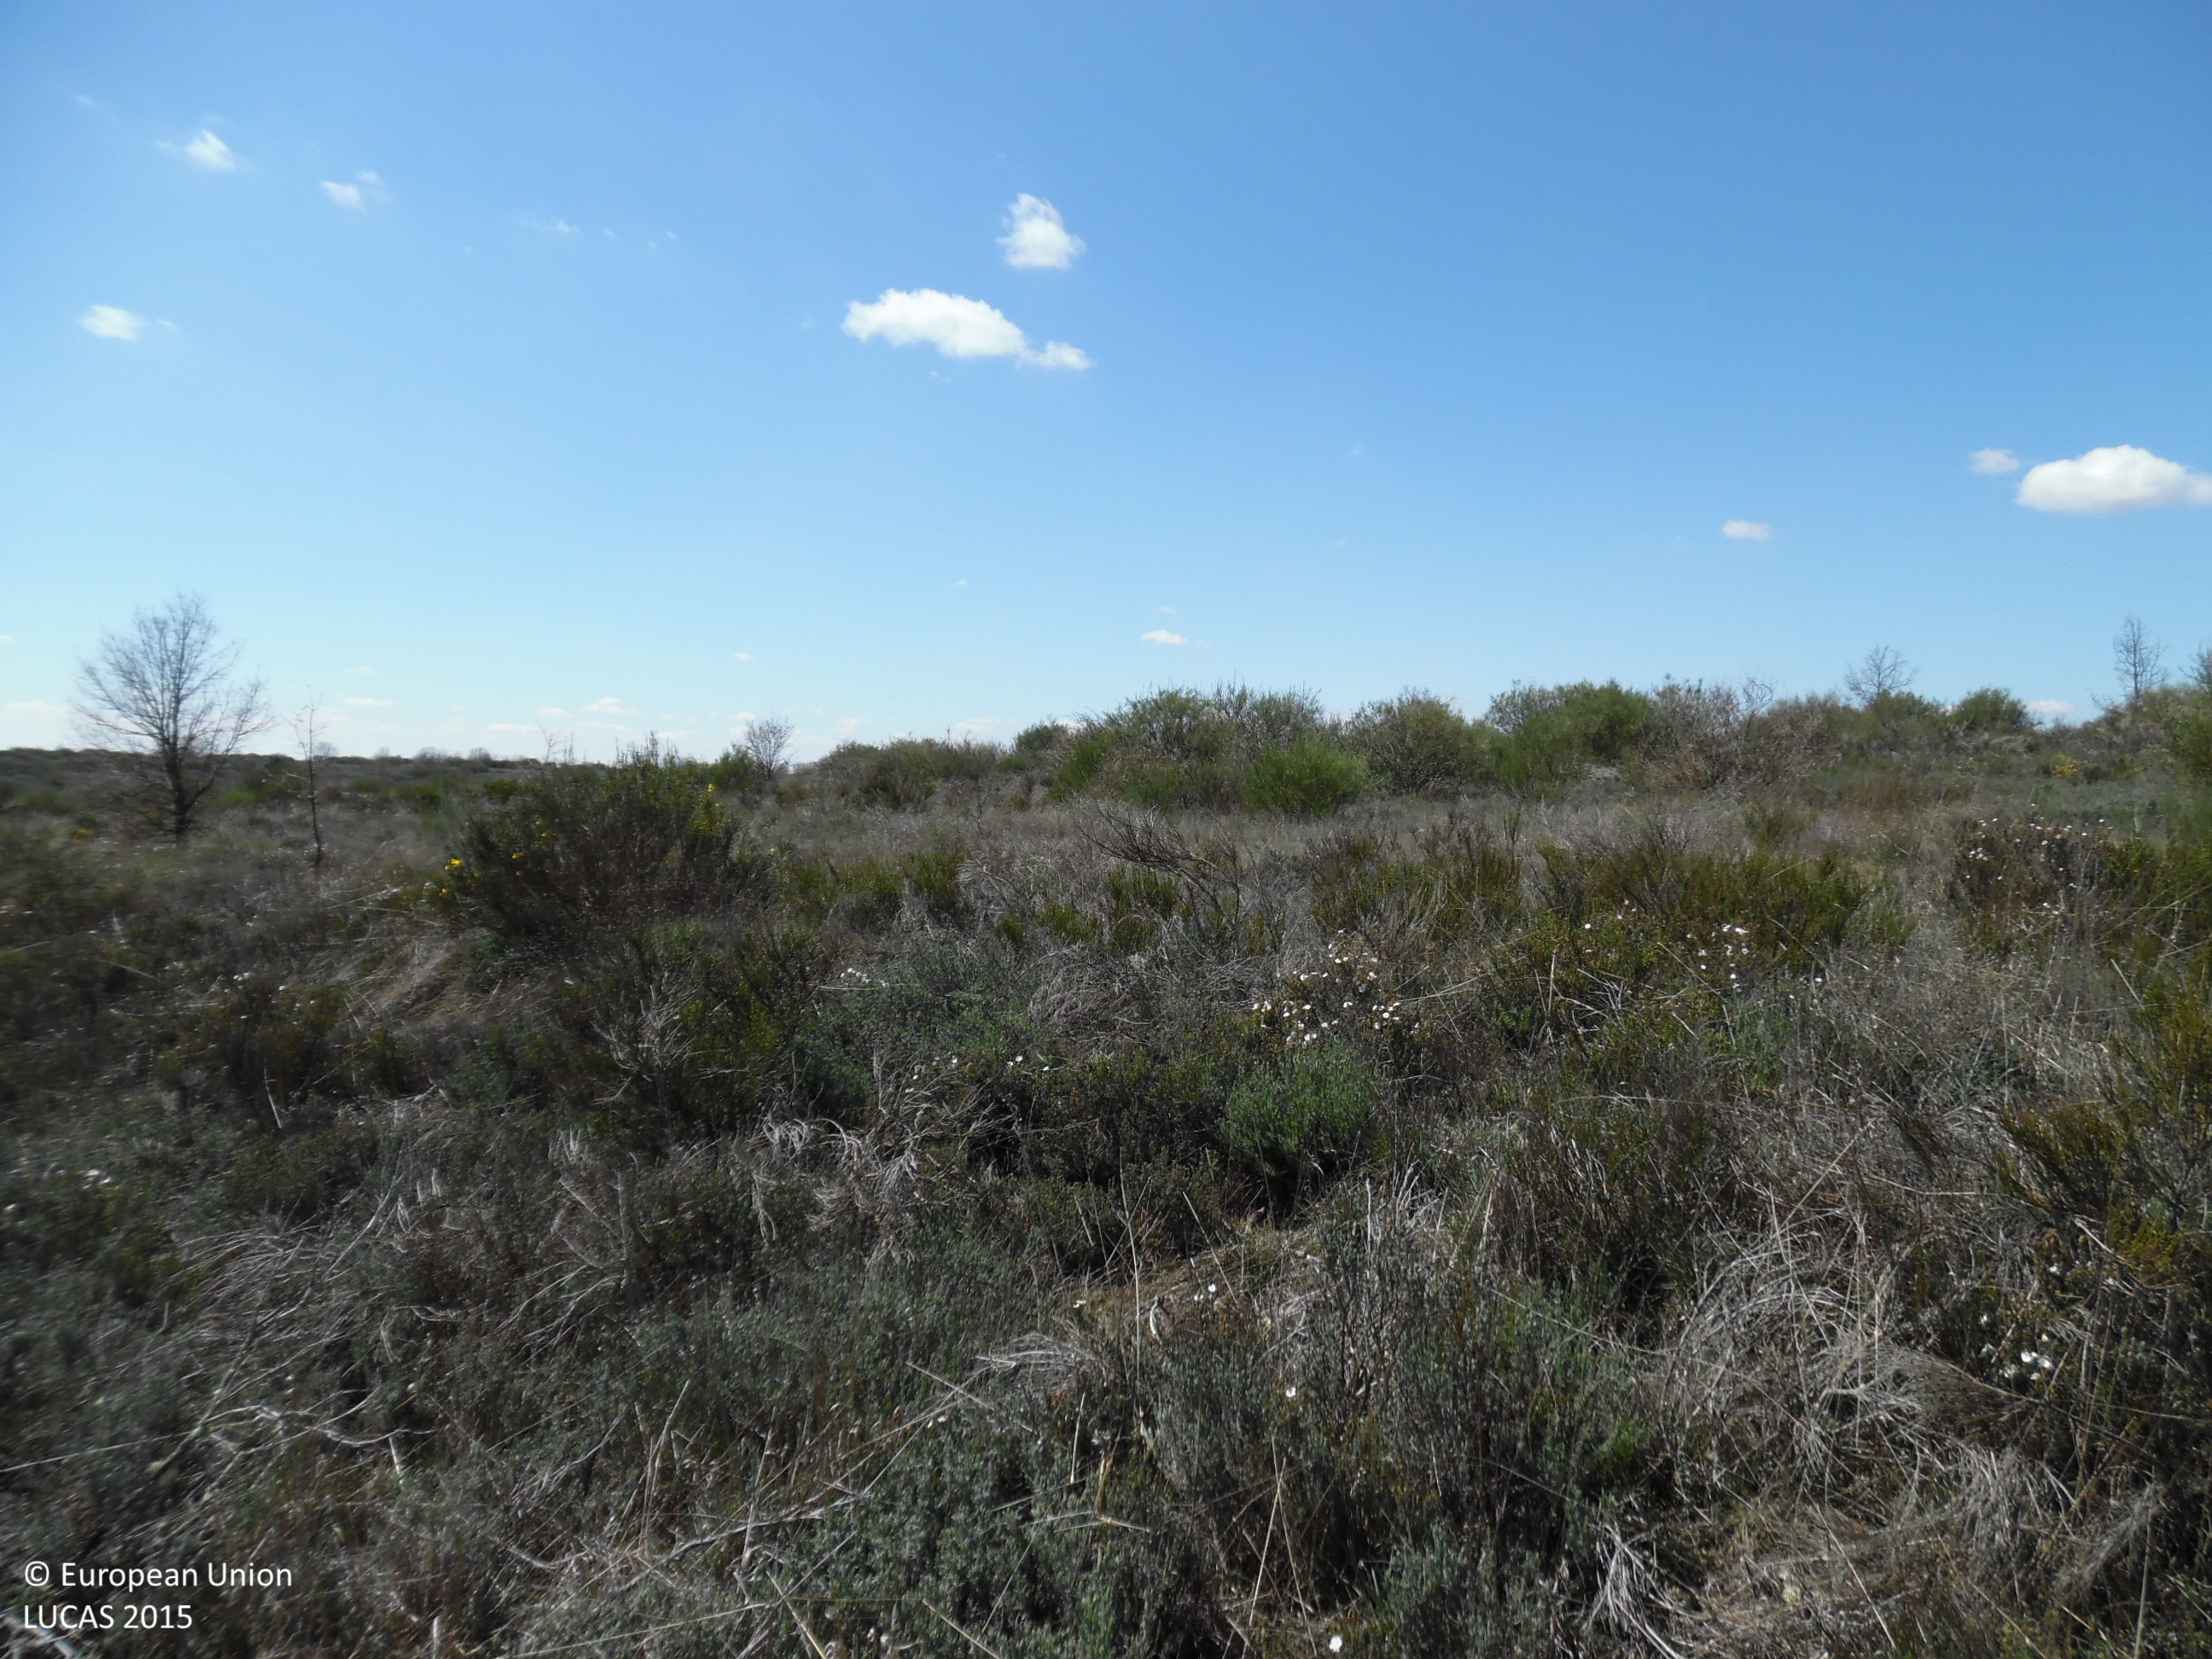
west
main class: Shrubland
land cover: Shrubland without tree cover
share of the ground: > 75 %
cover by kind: shrubs 95 %, herbaceous plants 5 %
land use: Abandoned areas
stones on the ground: 10 - 25 %
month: April
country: ES
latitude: 42.6016
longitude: -5.6636
